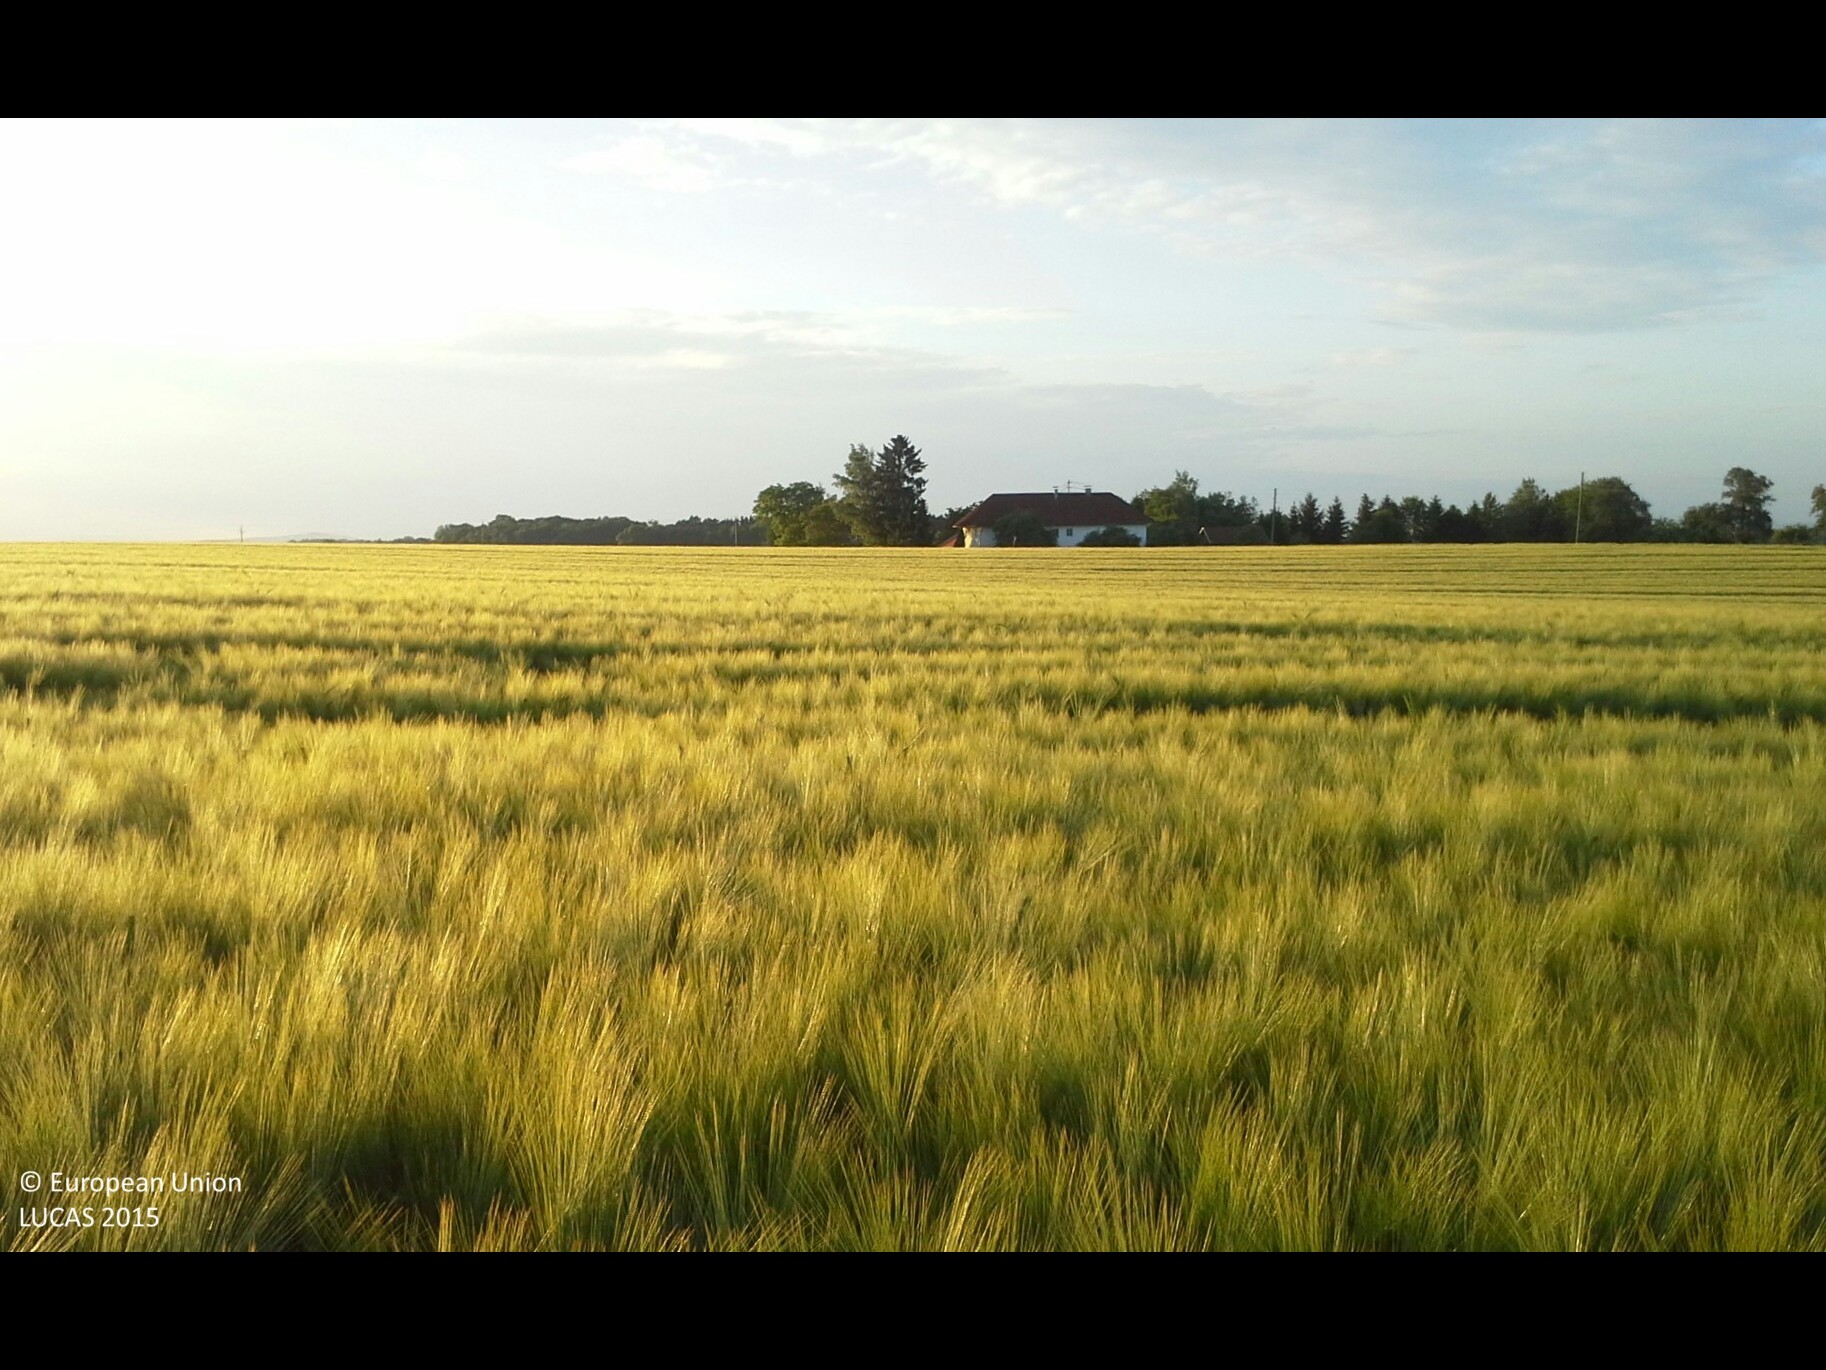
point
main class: Cropland
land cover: Barley
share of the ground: > 75 %
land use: Agriculture (excluding fallow land and kitchen gardens)
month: May
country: AT
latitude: 48.1392
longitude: 14.3138
